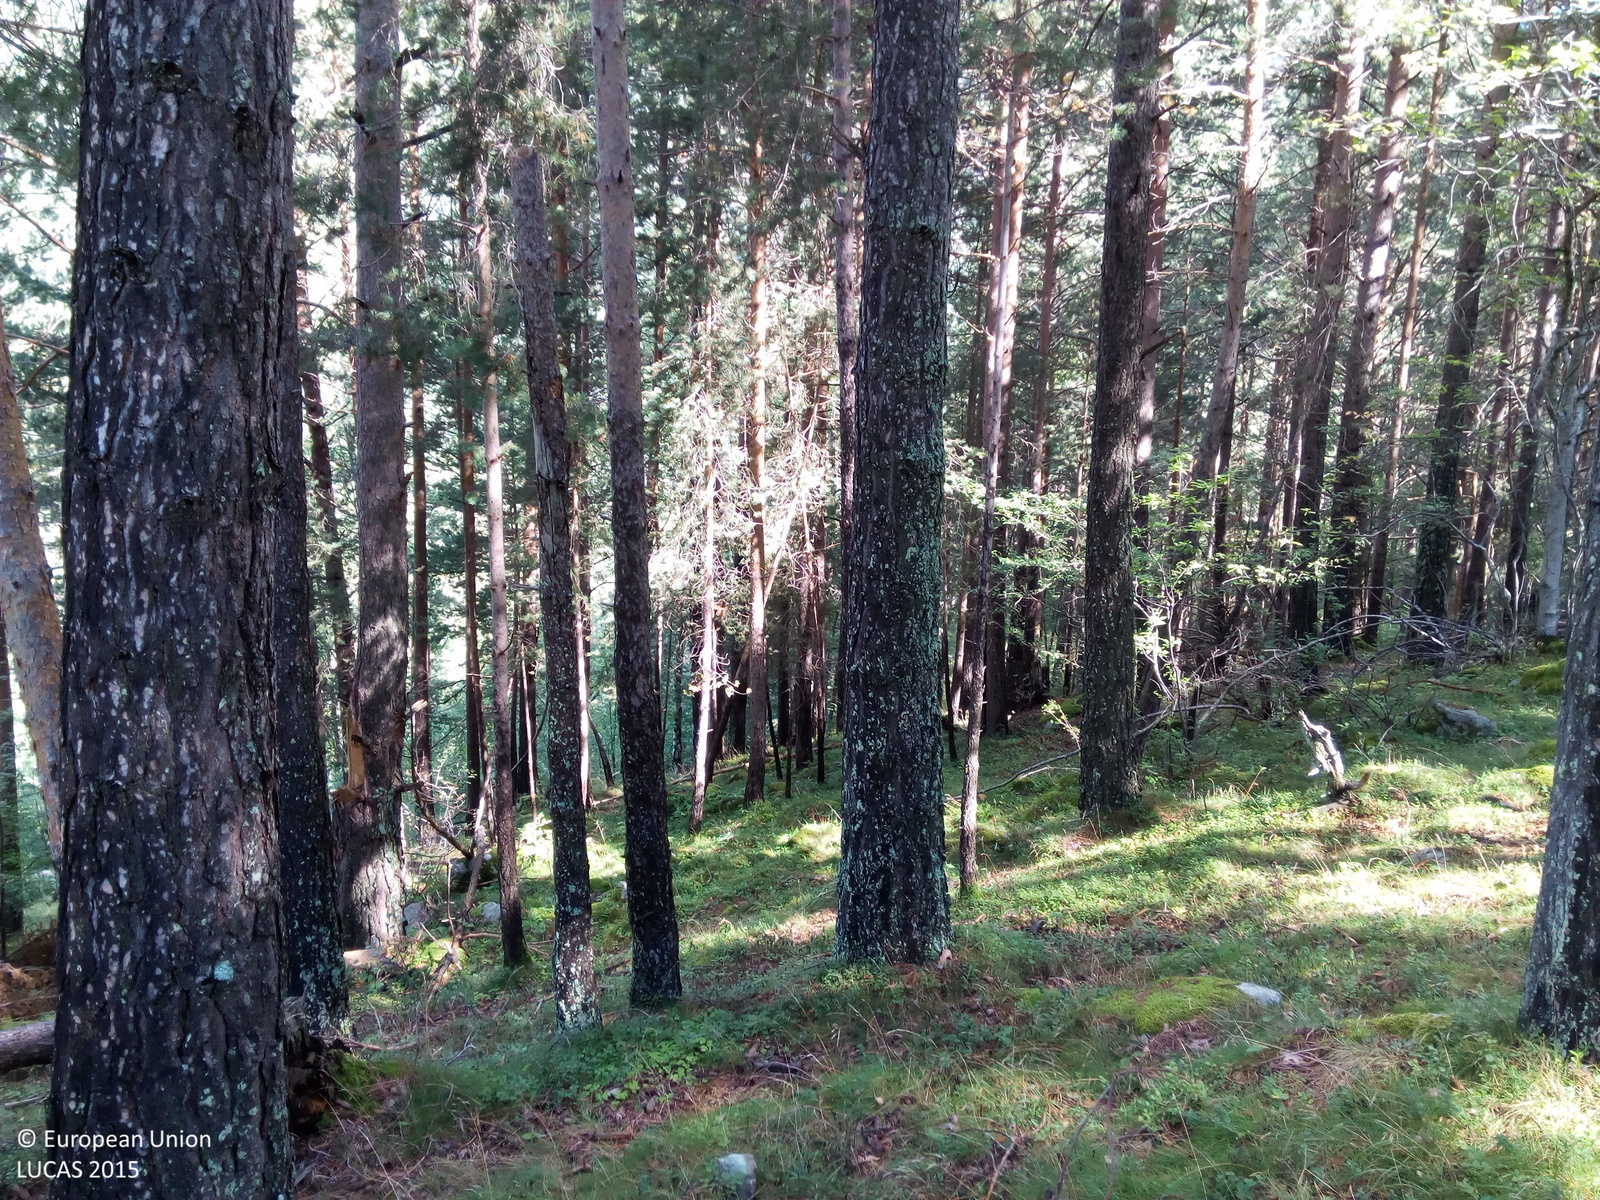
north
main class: Woodland
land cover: Pine dominated coniferous woodland
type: alpine coniferous forest
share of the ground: > 75 %
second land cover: Grassland without tree/shrub cover
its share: 10 - 25 %
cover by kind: coniferous forest trees 75 %, shrubs 15 %, herbaceous plants 10 %
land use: Forestry
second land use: Agriculture (excluding fallow land and kitchen gardens)
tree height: > 5 m
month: September
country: ES
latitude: 42.6471
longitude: 0.3549
